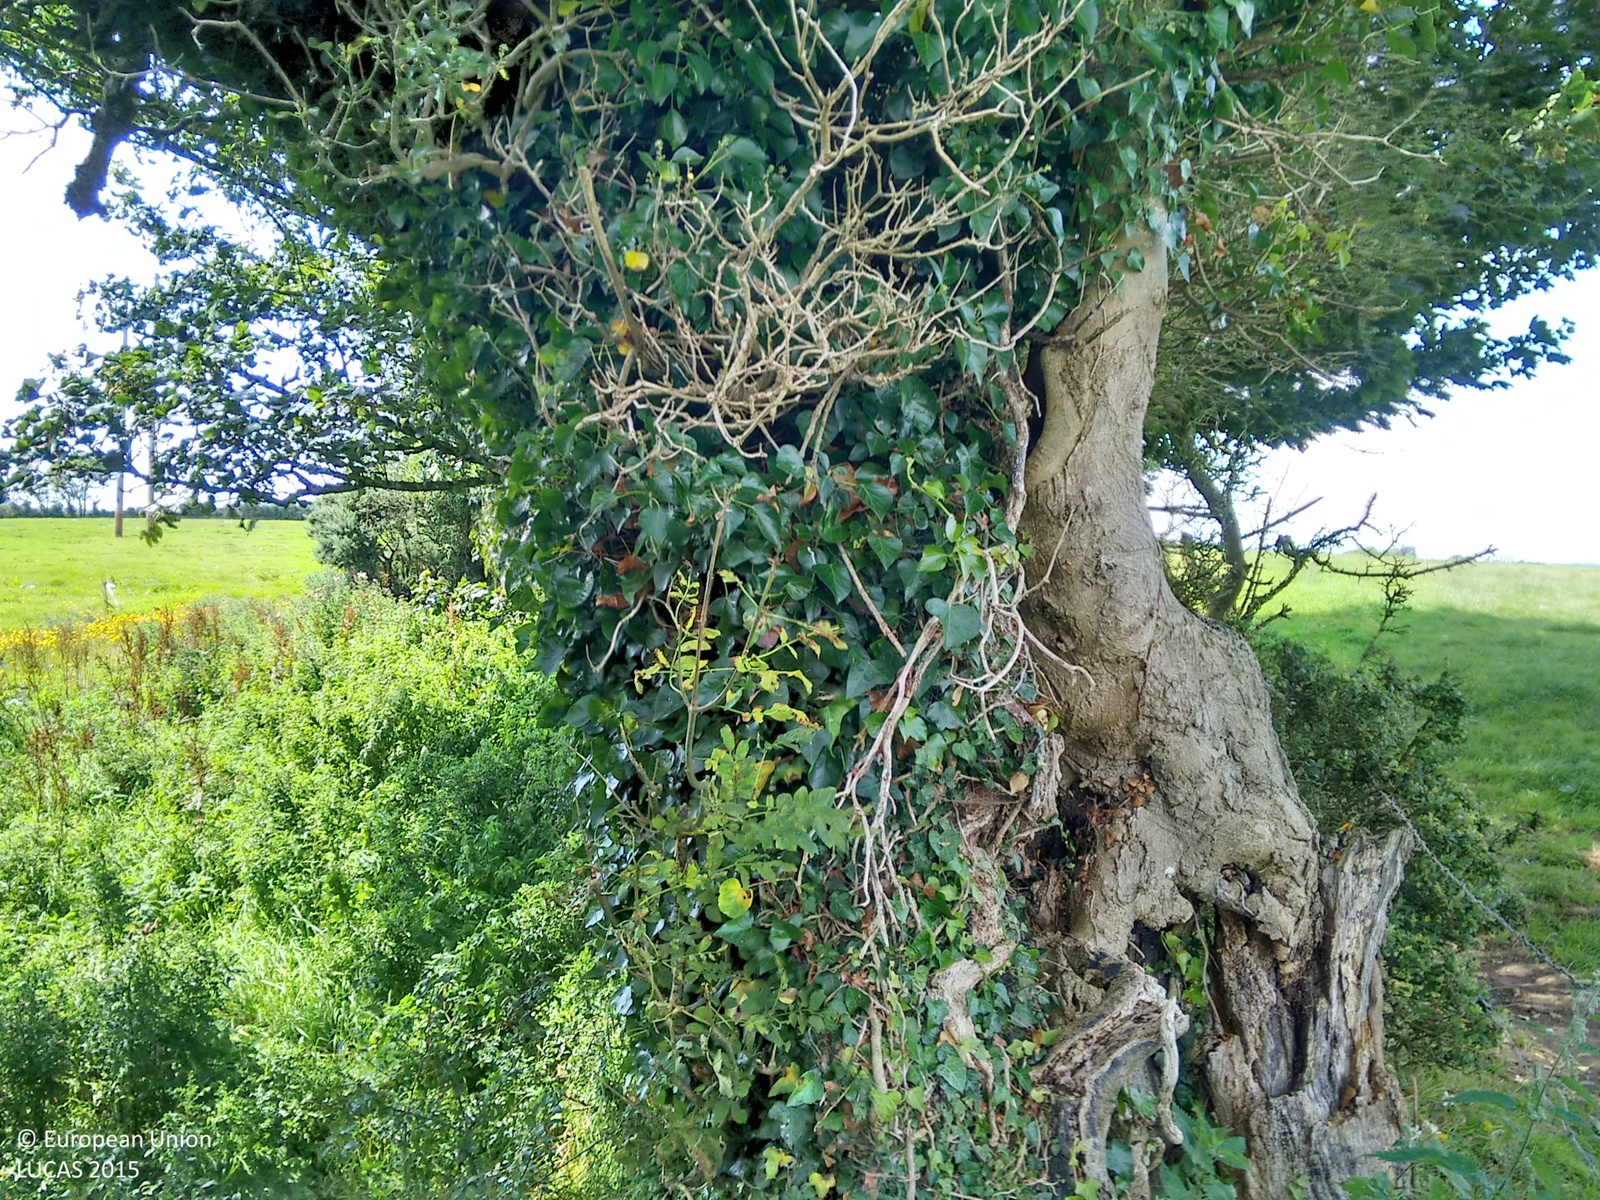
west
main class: Grassland
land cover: Grassland without tree/shrub cover
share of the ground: > 75 %
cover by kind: herbaceous plants 100 %
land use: Agriculture (excluding fallow land and kitchen gardens)
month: August
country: IE
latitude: 52.3426
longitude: -6.5546
